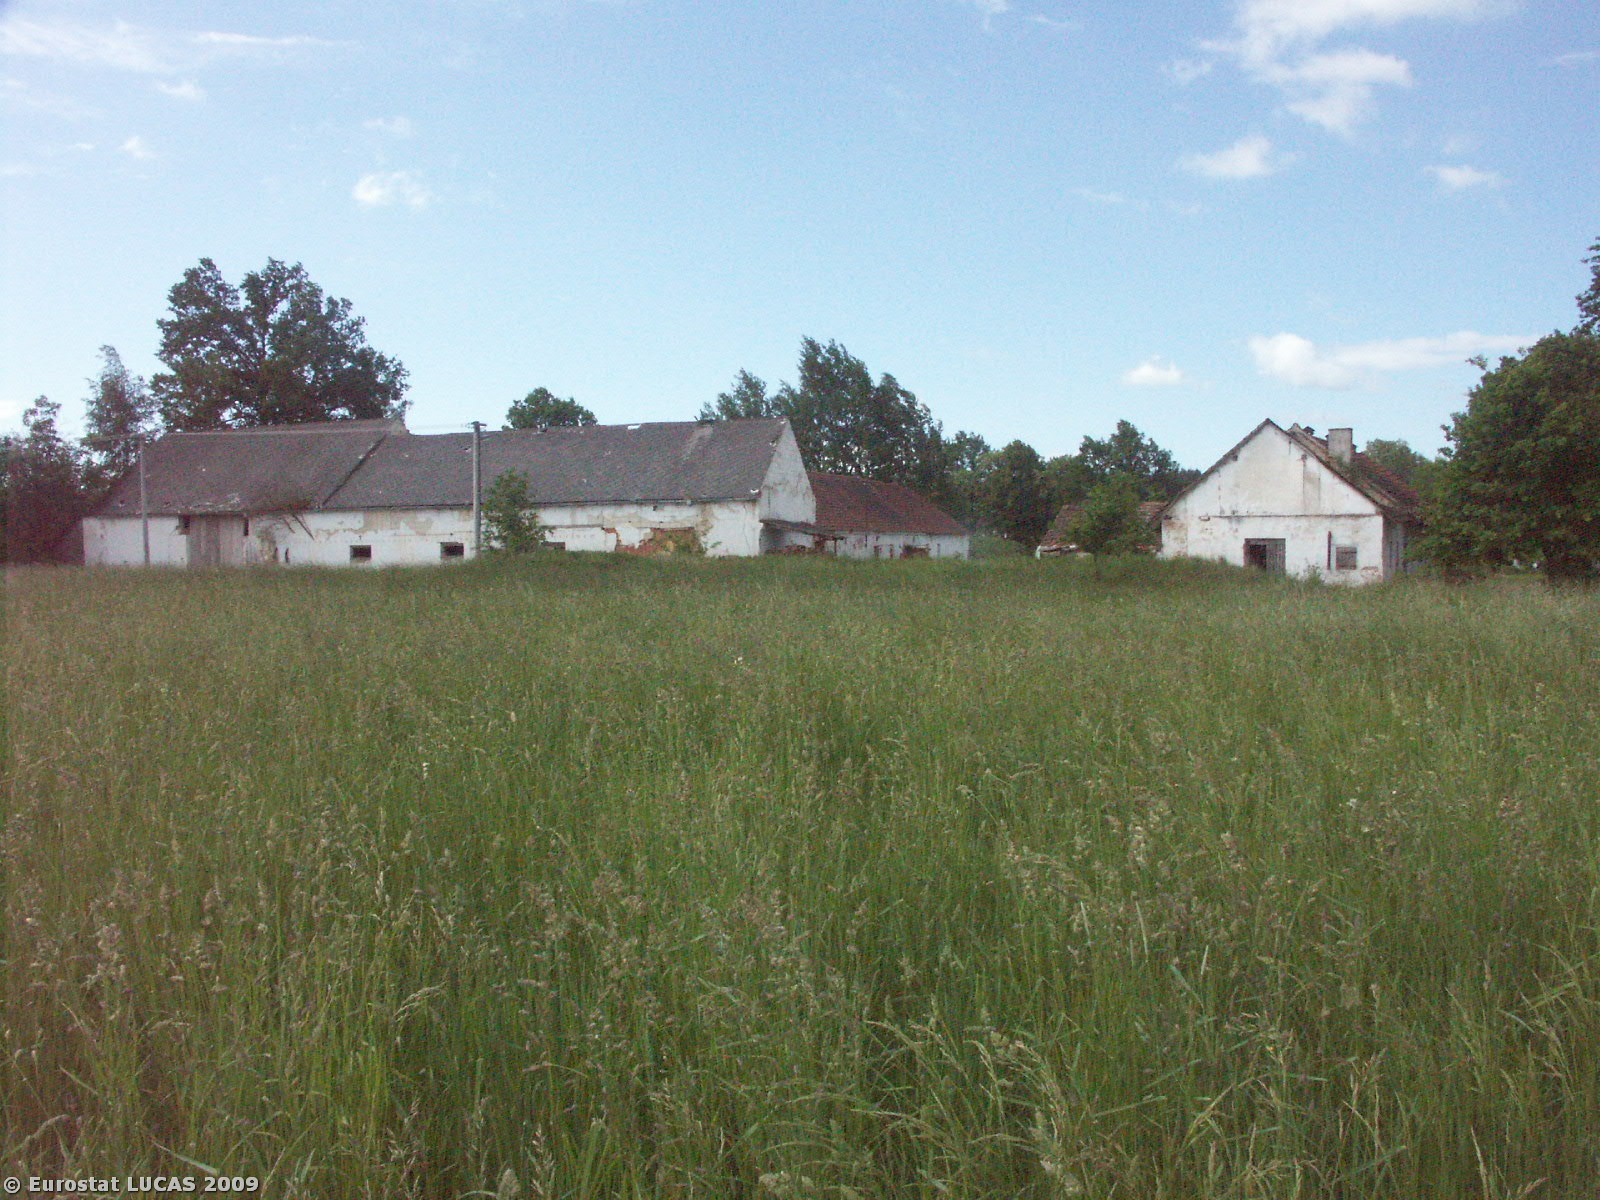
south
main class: Grassland
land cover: Grassland without tree/shrub cover
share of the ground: > 75 %
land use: Agriculture (excluding fallow land and kitchen gardens)
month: May
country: CZ
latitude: 48.9350
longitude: 14.6837
